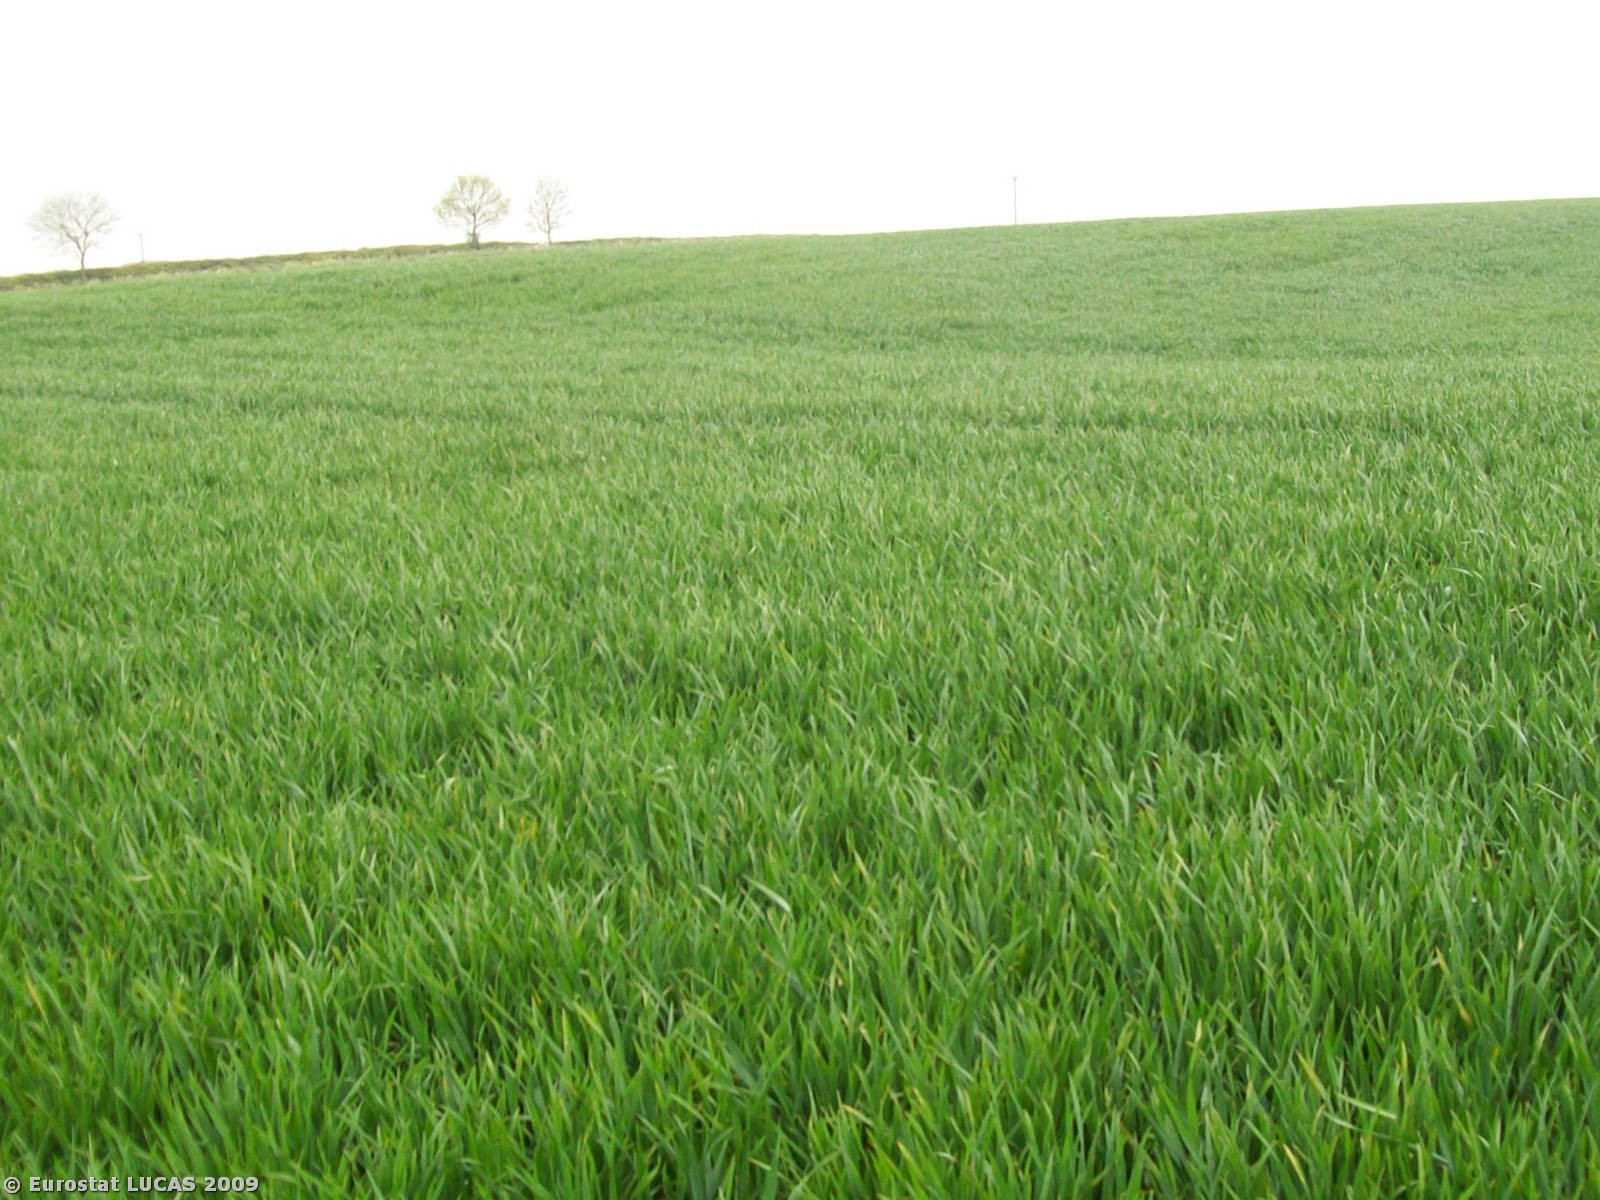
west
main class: Cropland
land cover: Common wheat
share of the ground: > 75 %
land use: Agriculture (excluding fallow land and kitchen gardens)
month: May
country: GB
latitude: 52.8035
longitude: -0.8556
